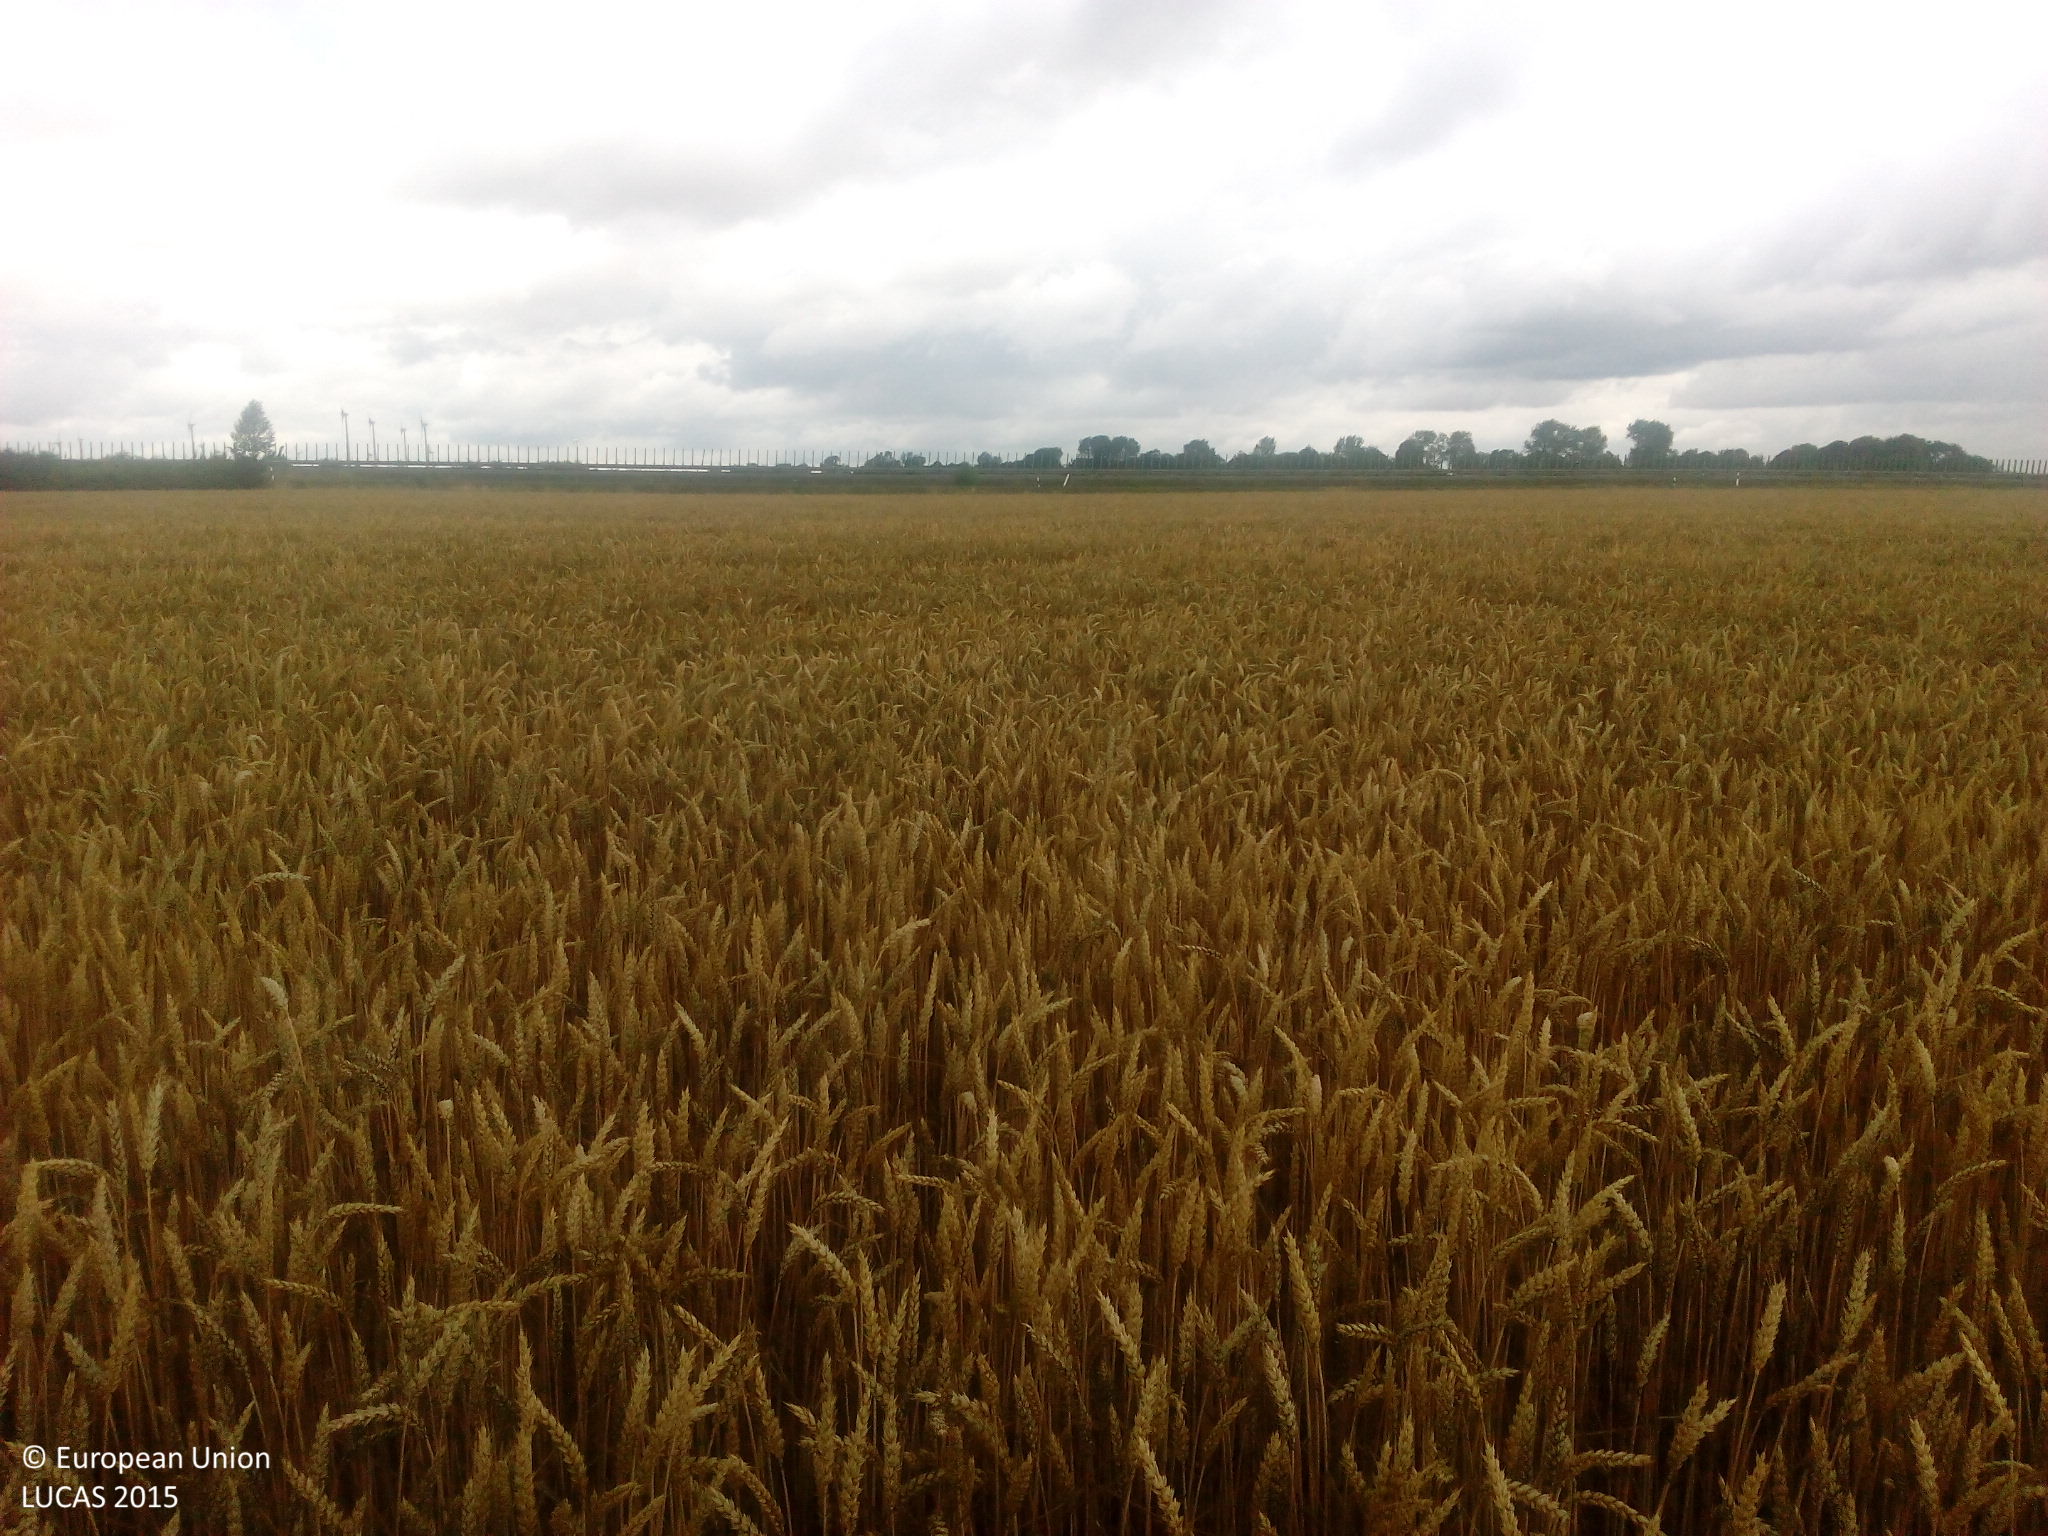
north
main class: Cropland
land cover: Common wheat
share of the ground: > 75 %
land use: Agriculture (excluding fallow land and kitchen gardens)
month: July
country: DE
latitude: 51.7745
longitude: 11.5214
